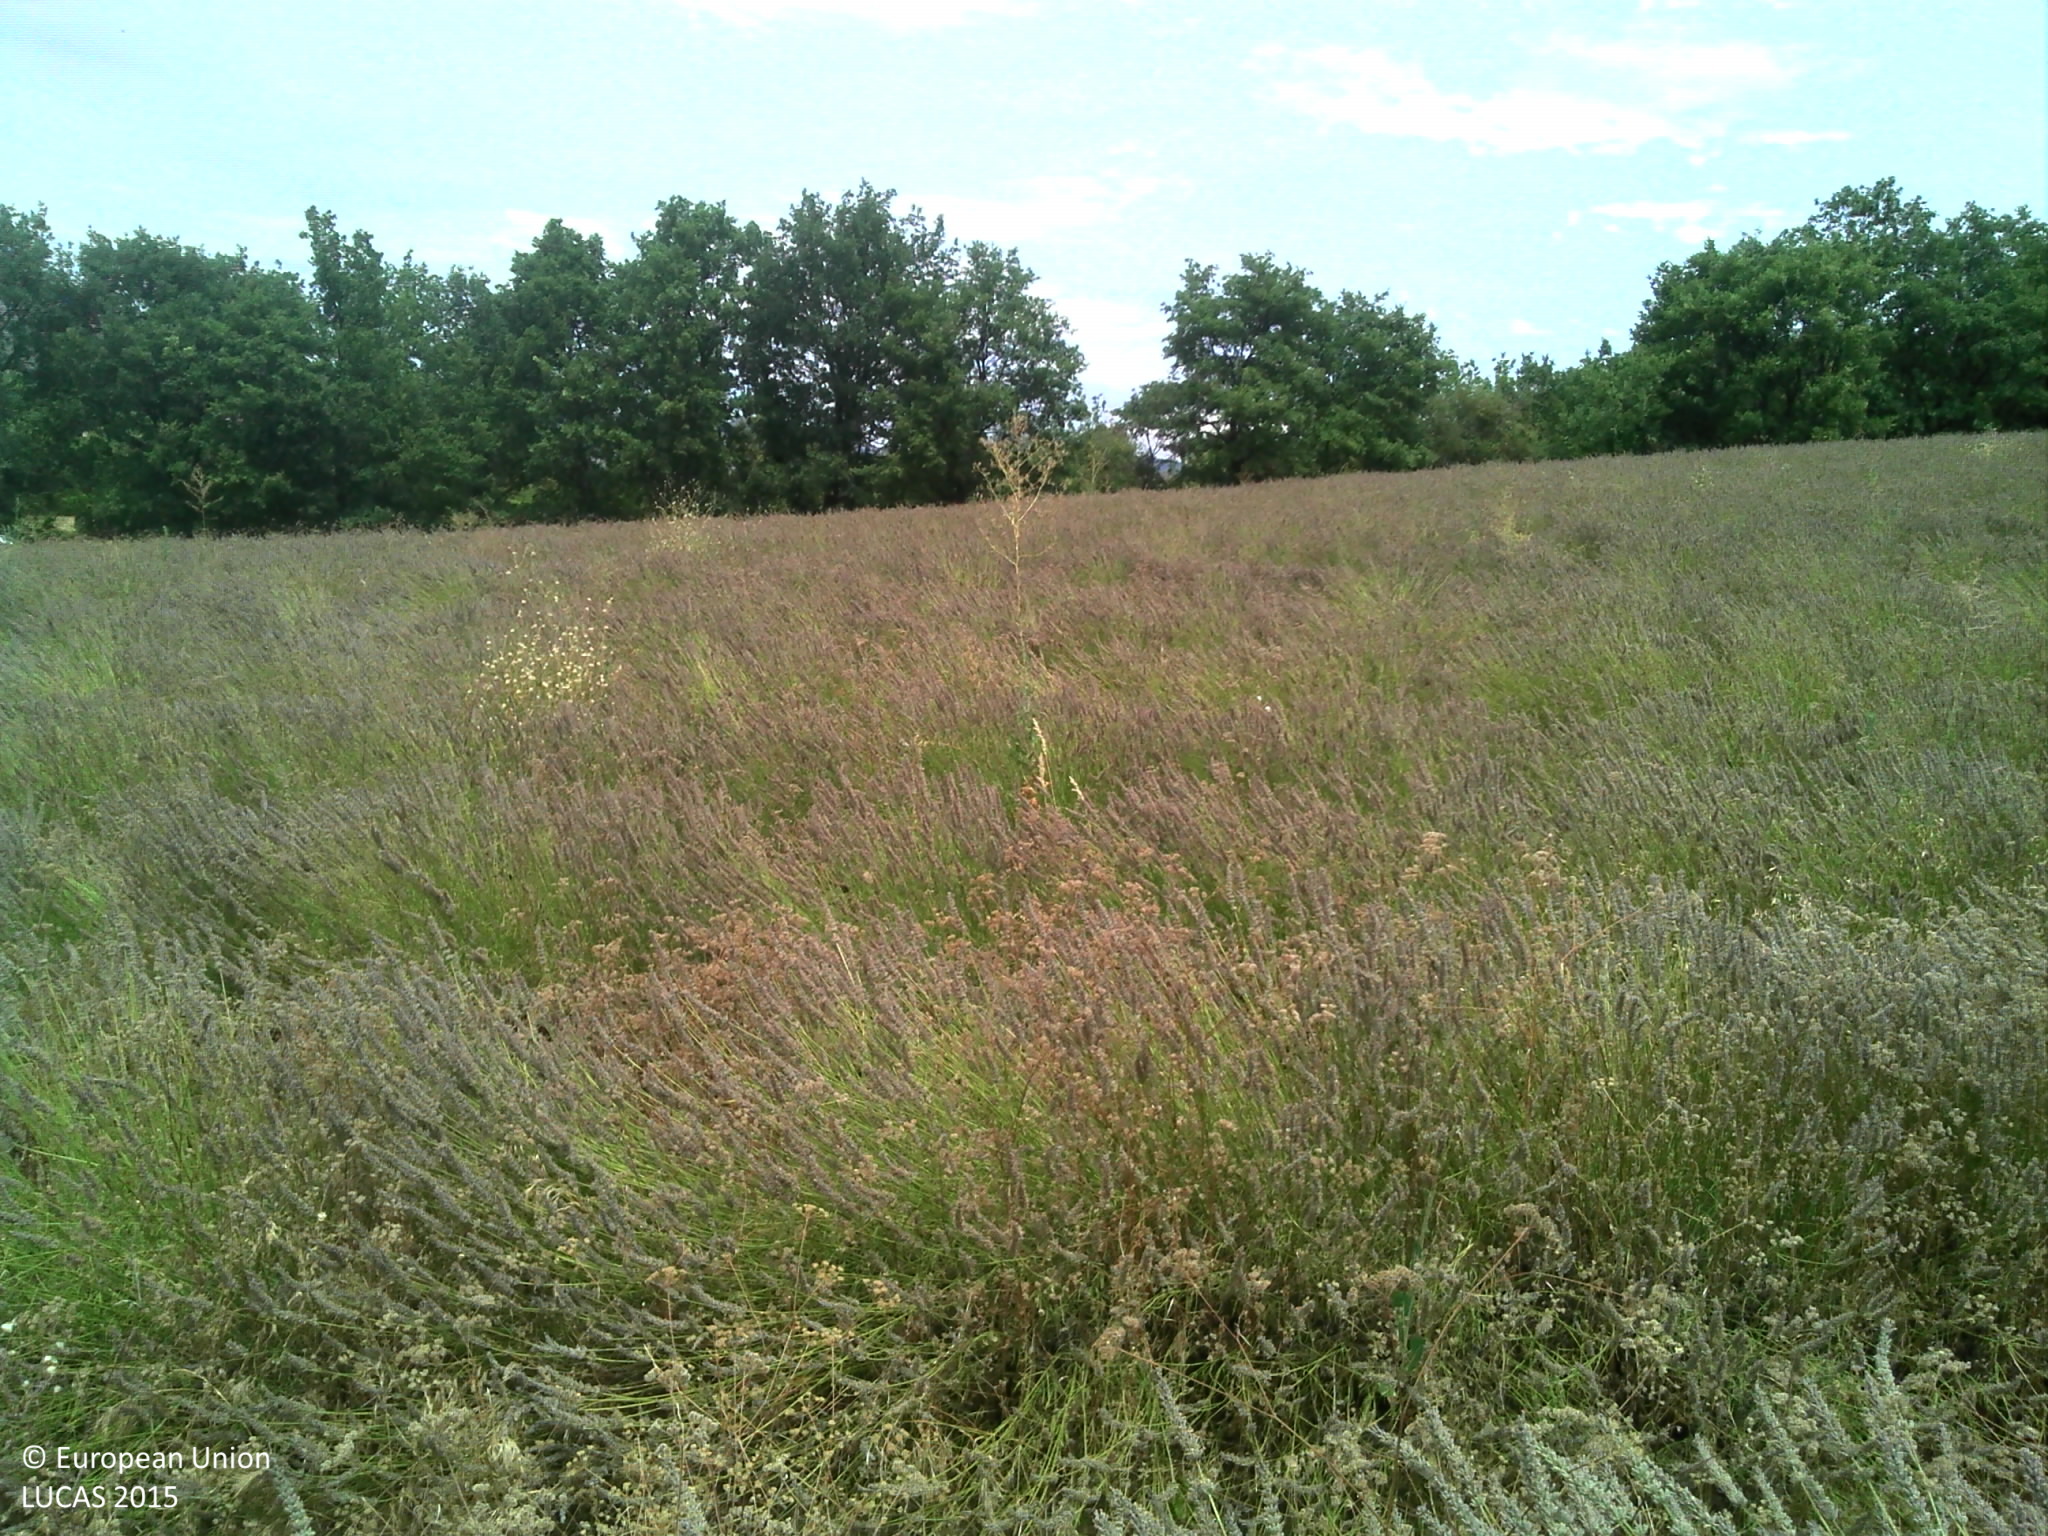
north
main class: Cropland
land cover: Floriculture and ornamental plants
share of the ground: > 75 %
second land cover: Spontaneously vegetated surfaces
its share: 50 - 75 %
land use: Agriculture (excluding fallow land and kitchen gardens)
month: July
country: FR
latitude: 44.5164
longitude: 4.5845
